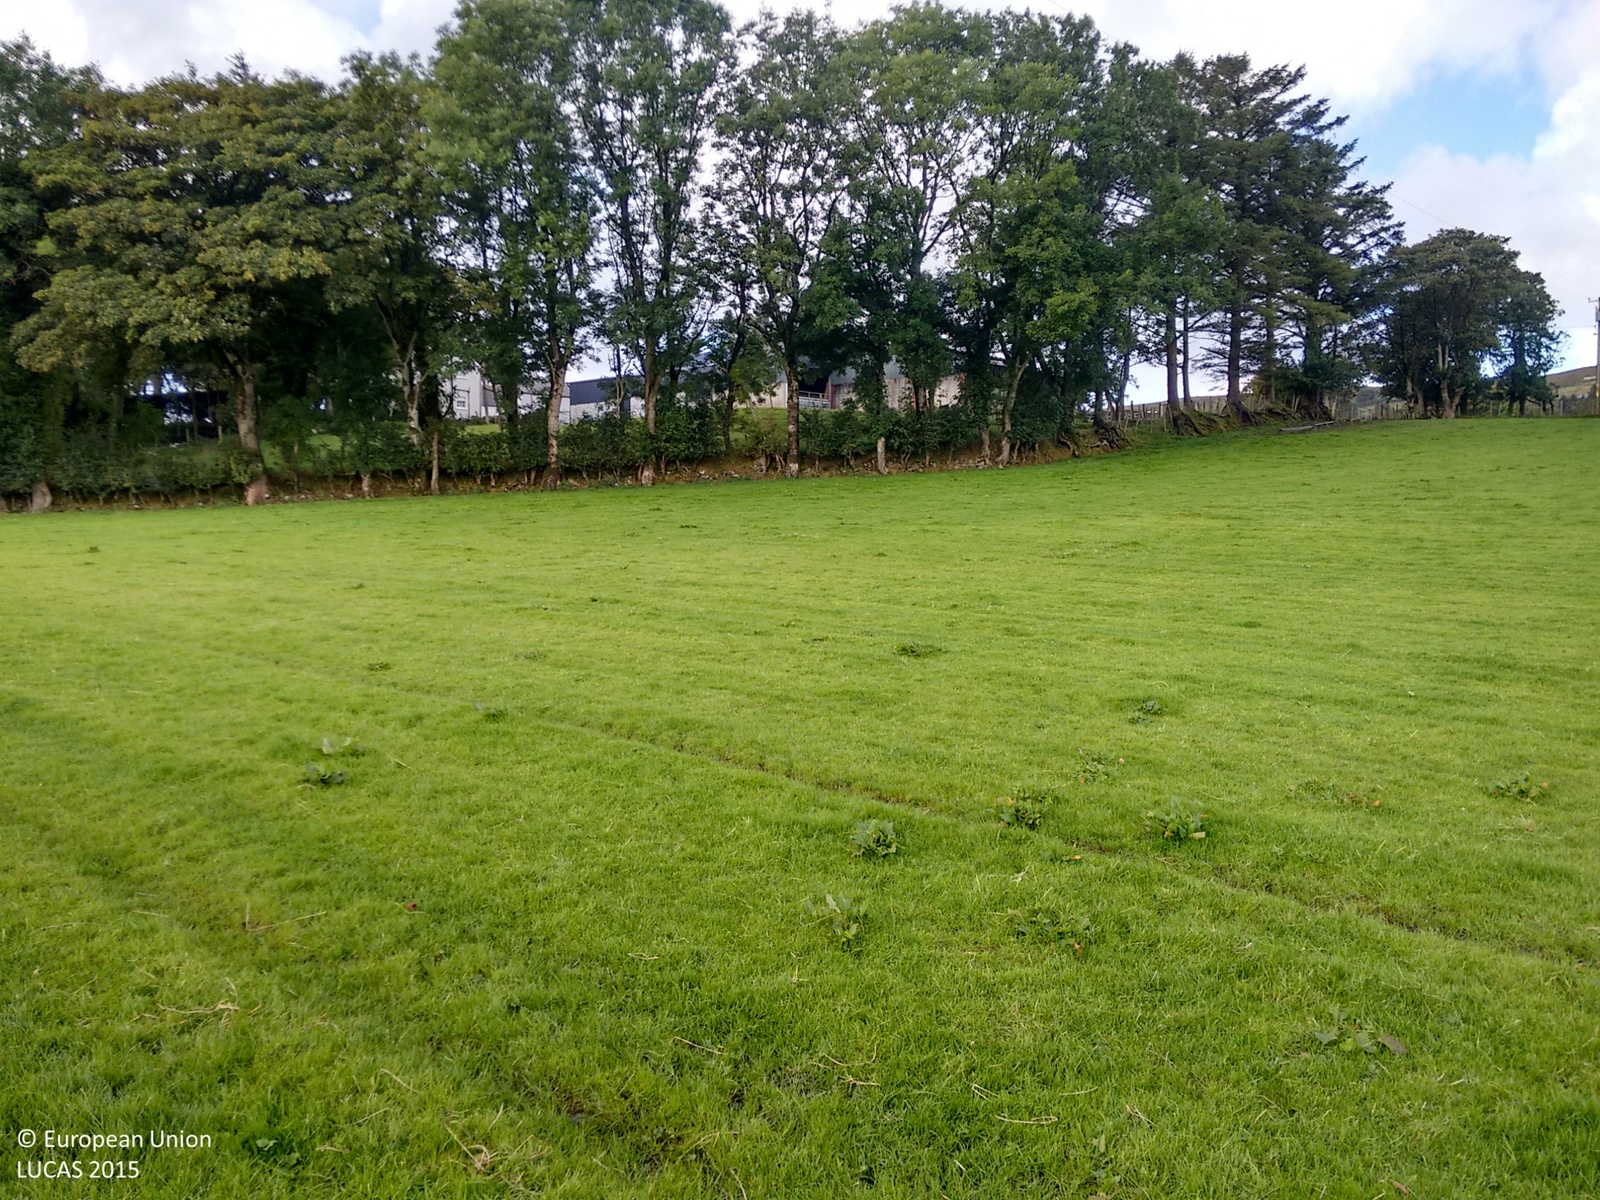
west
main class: Grassland
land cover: Grassland without tree/shrub cover
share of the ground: > 75 %
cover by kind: herbaceous plants 100 %
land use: Agriculture (excluding fallow land and kitchen gardens)
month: September
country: IE
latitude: 55.1859
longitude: -7.4111
